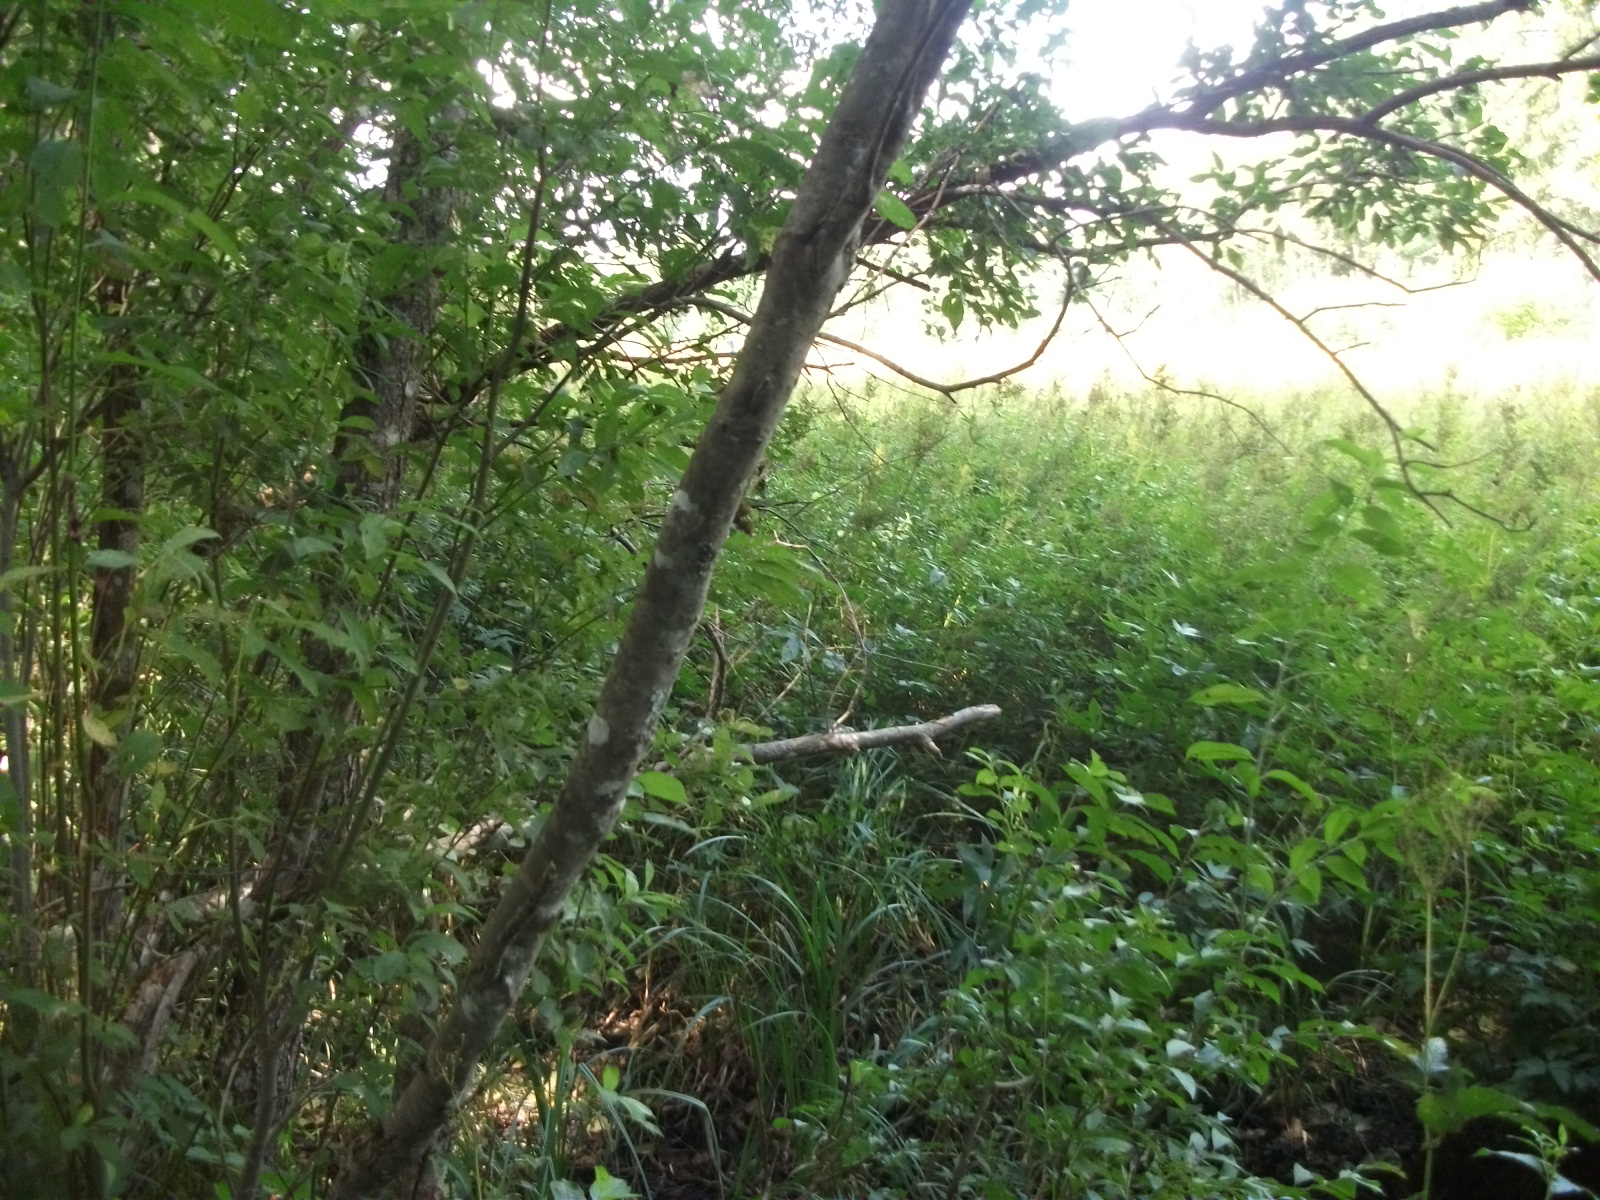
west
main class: Woodland
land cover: Broadleaved woodland
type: non-riverine alder, birch or aspen forest
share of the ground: > 75 %
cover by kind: broadleaved forest trees 90 %, shrubs 5 %, herbaceous plants 5 %
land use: Forestry
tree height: > 5 m
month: August
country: LV
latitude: 56.9045
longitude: 26.4163
